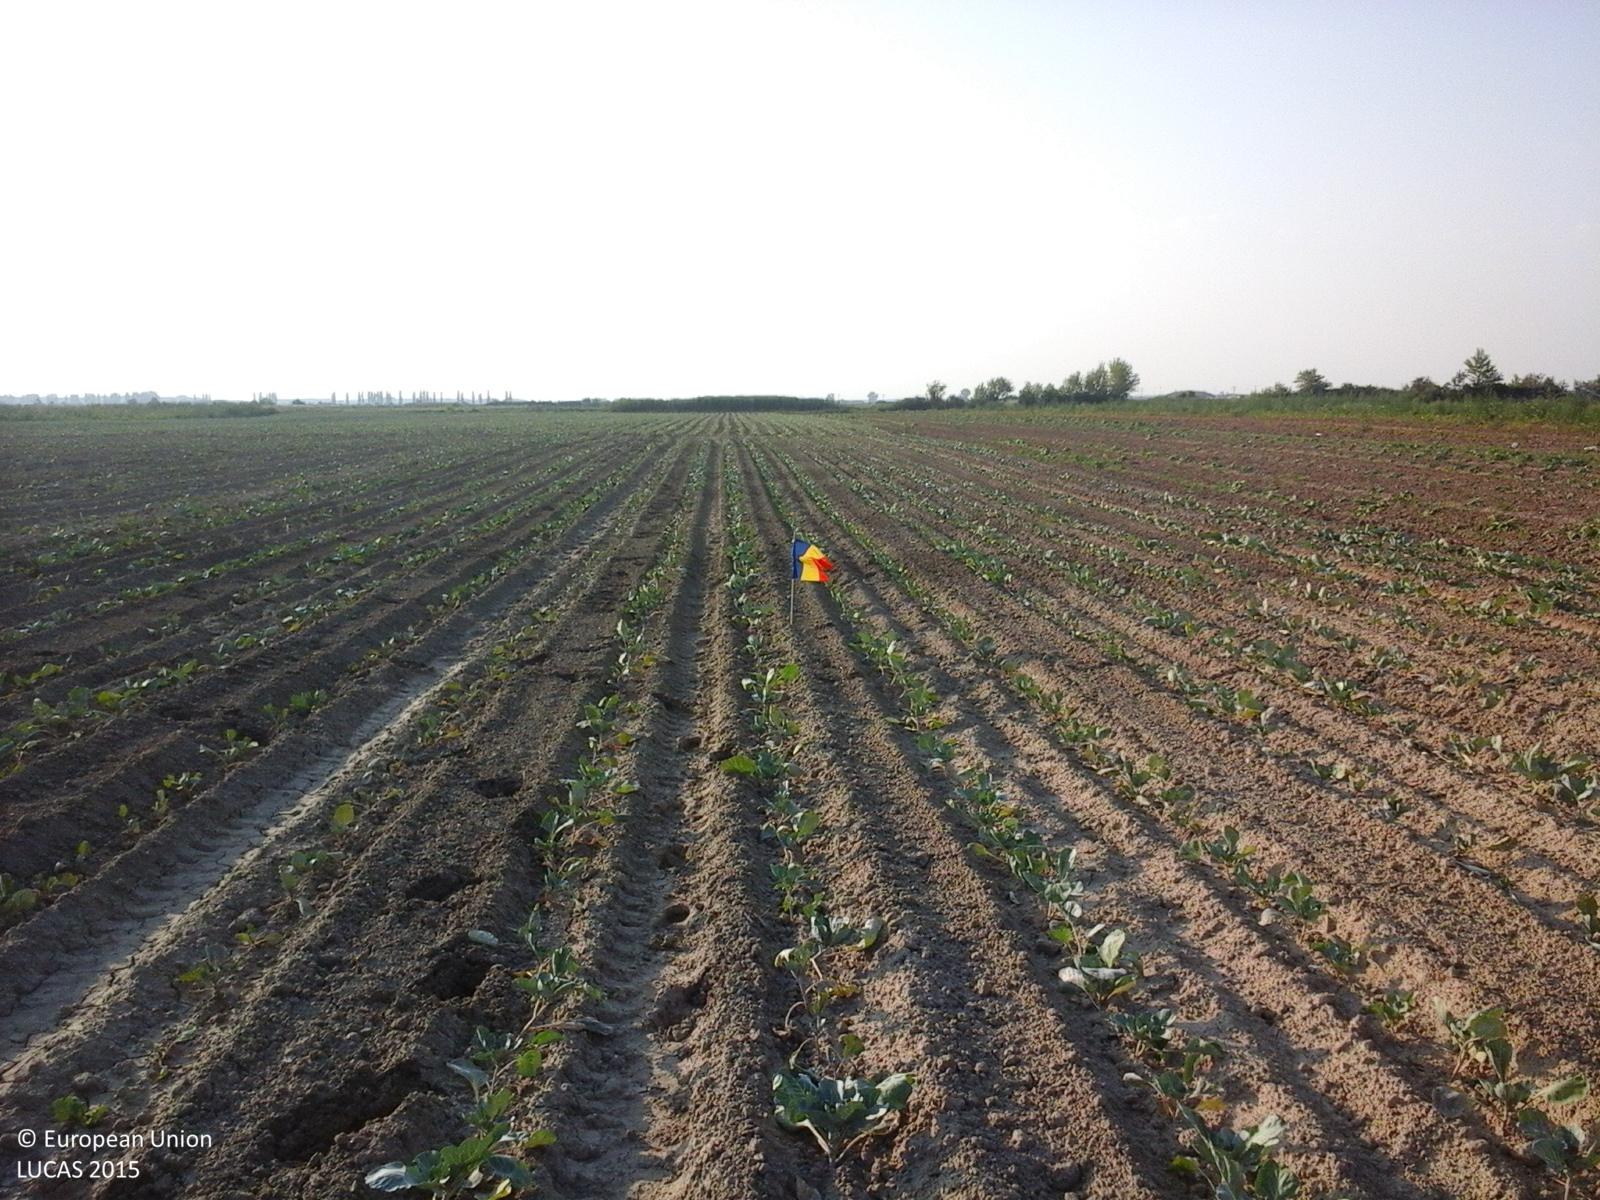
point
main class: Cropland
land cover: Other fresh vegetables
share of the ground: 10 - 25 %
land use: Agriculture (excluding fallow land and kitchen gardens)
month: July
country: RO
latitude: 44.6339
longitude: 25.6908
